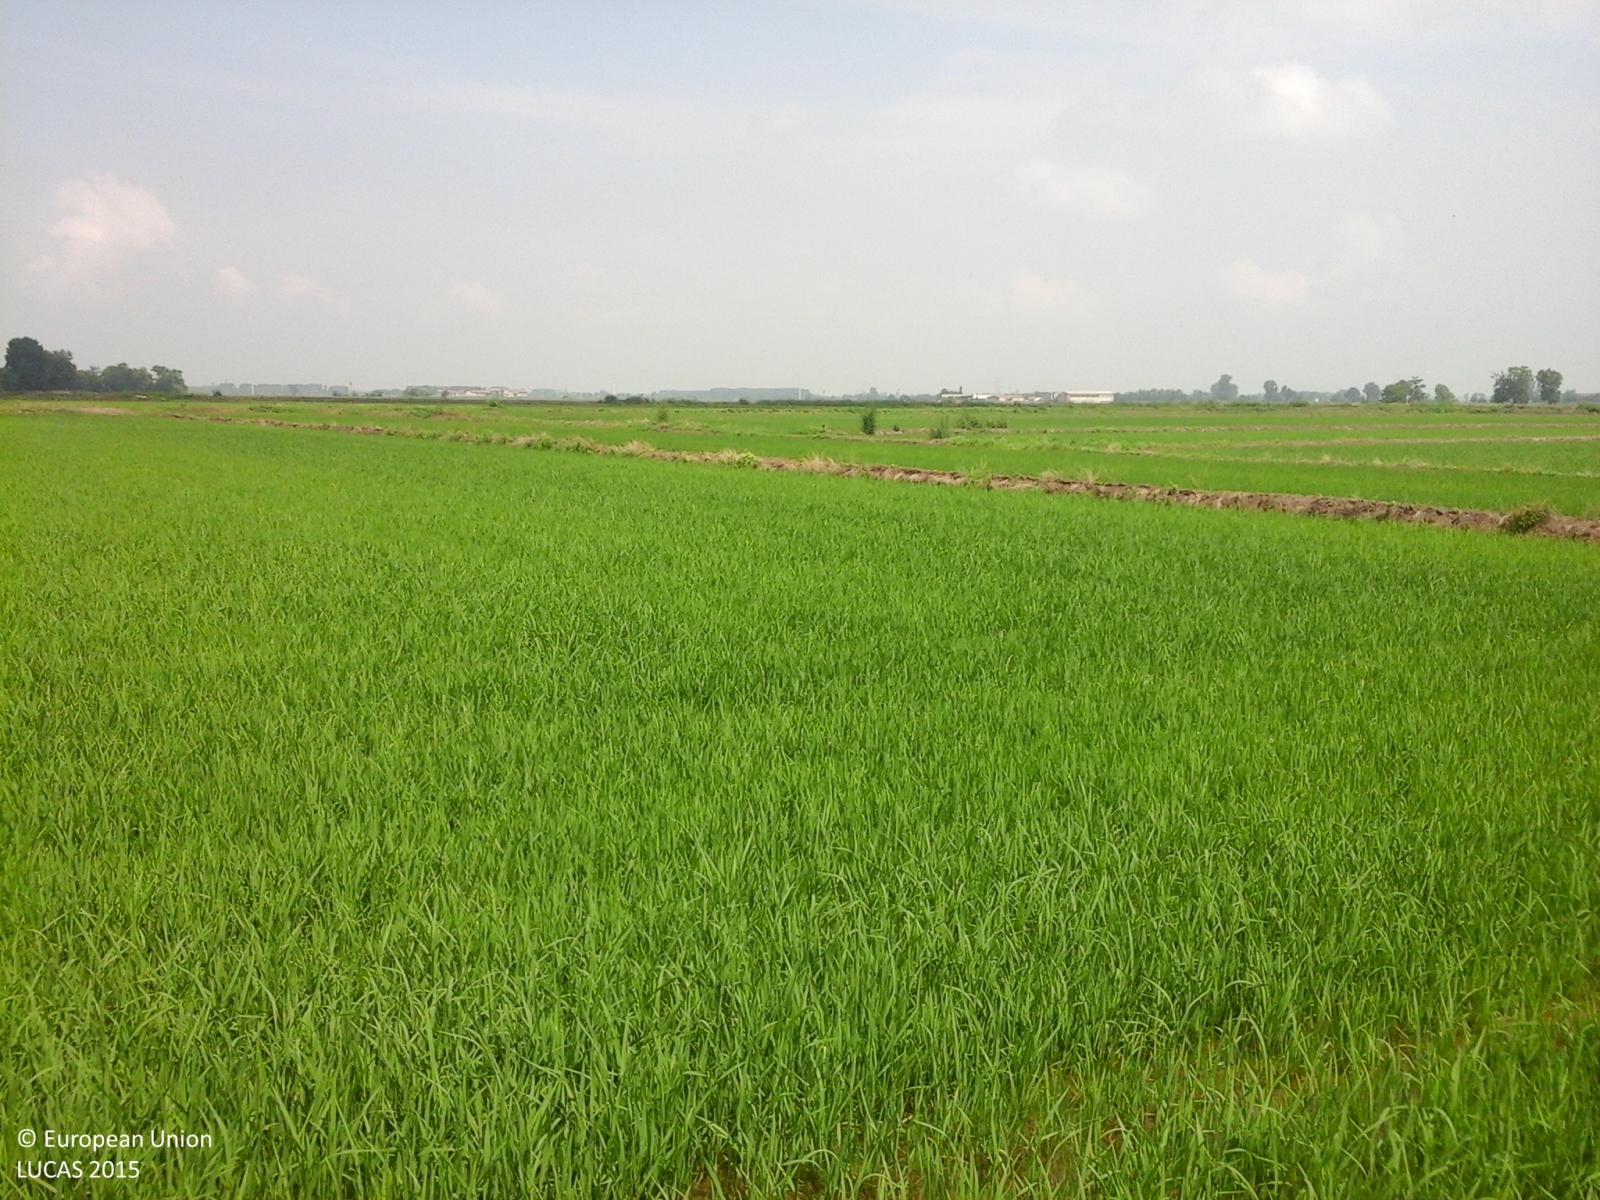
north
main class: Cropland
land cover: Rice
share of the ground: > 75 %
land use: Agriculture (excluding fallow land and kitchen gardens)
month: June
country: IT
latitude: 45.2426
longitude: 8.5884
